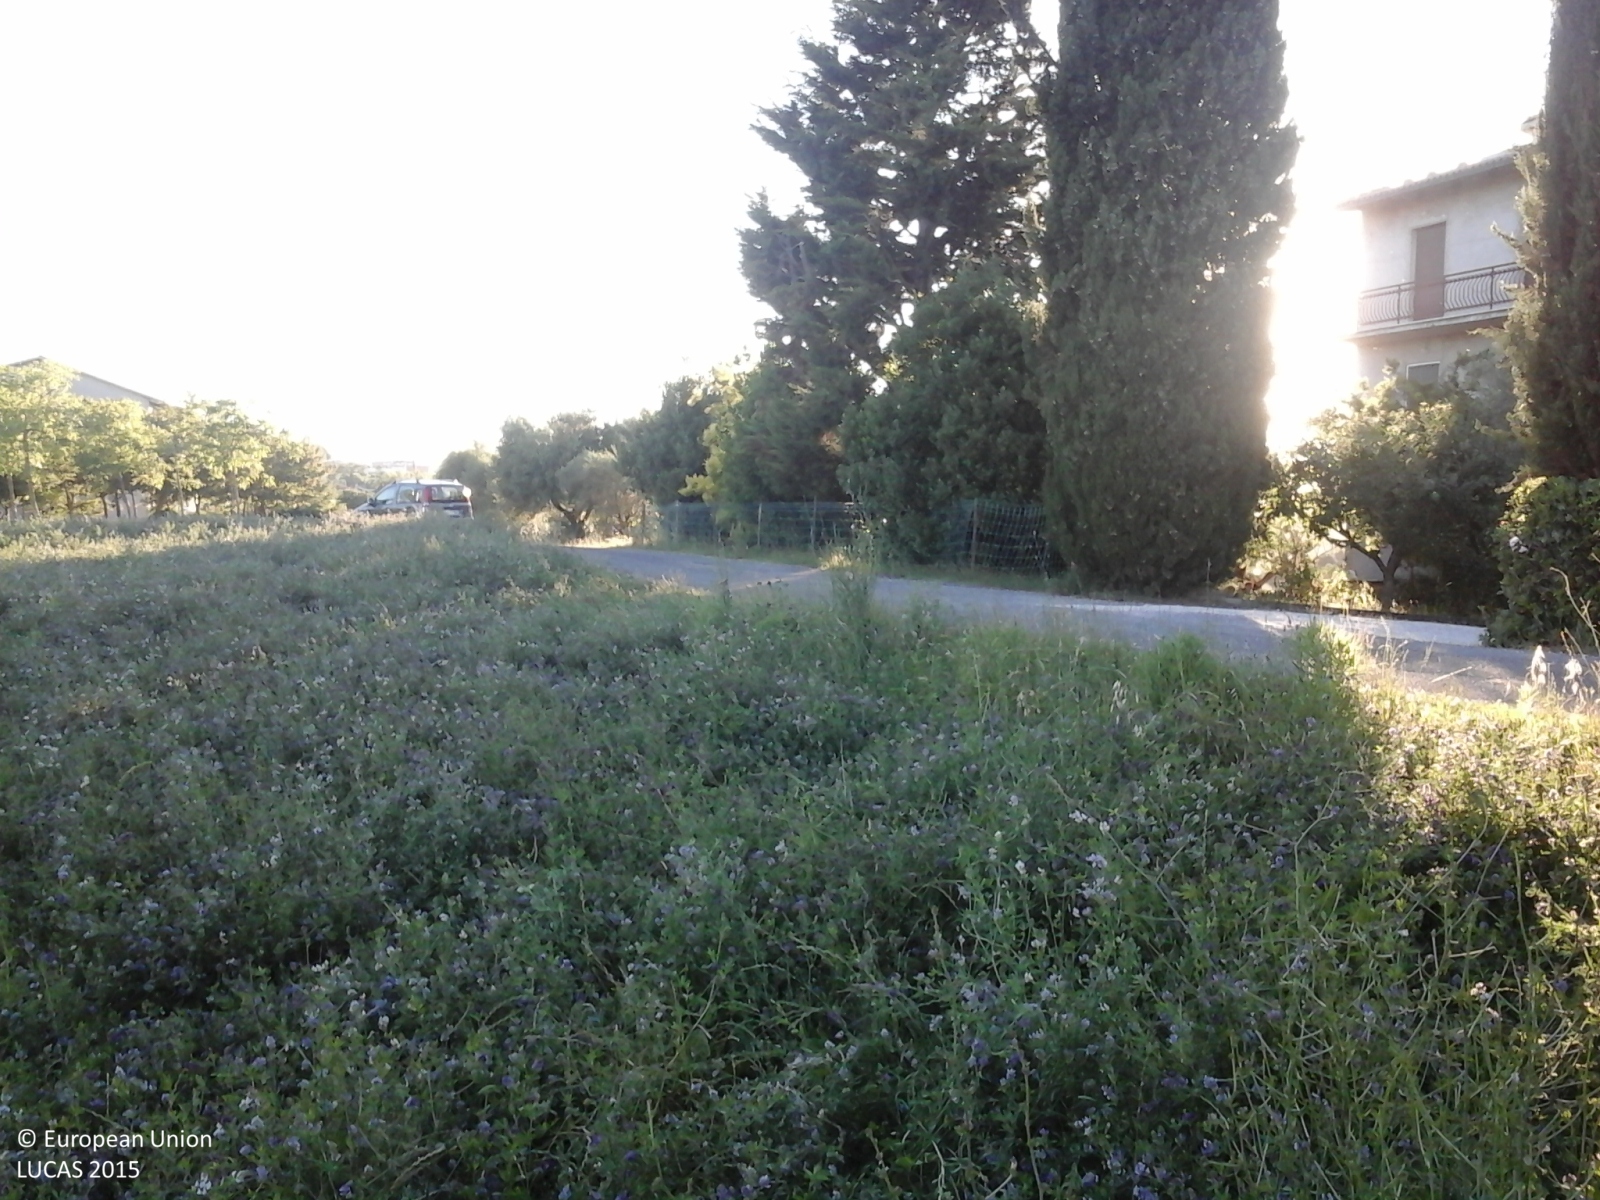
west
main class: Cropland
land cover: Lucerne
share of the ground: > 75 %
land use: Agriculture (excluding fallow land and kitchen gardens)
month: June
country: IT
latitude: 43.2269
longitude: 13.4753
